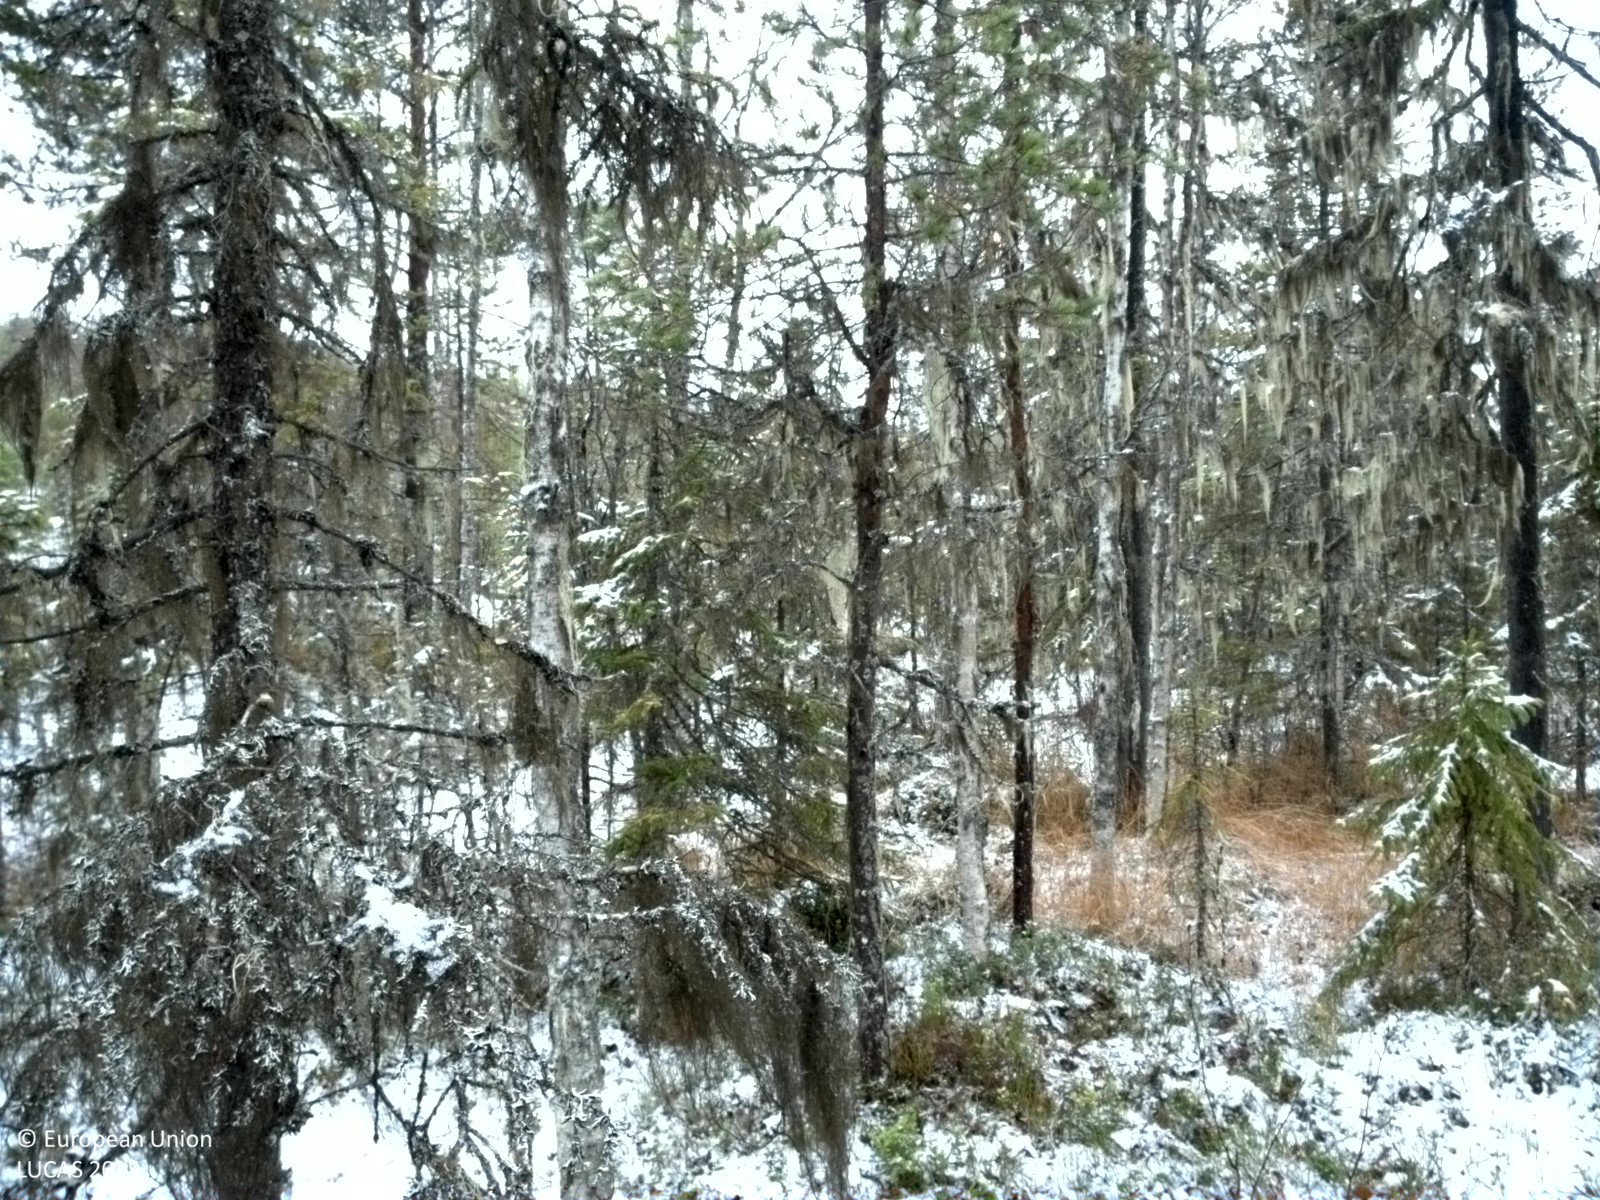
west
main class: Woodland
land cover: Spruce dominated mixed woodland
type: boreal forest
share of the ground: 25 - 50 %
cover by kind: shrubs 40 %, coniferous forest trees 30 %, lichens and mosses 15 %, broadleaved forest trees 10 %, herbaceous plants 5 %
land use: Forestry
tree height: > 5 m
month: November
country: SE
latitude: 63.9933
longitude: 16.0425
